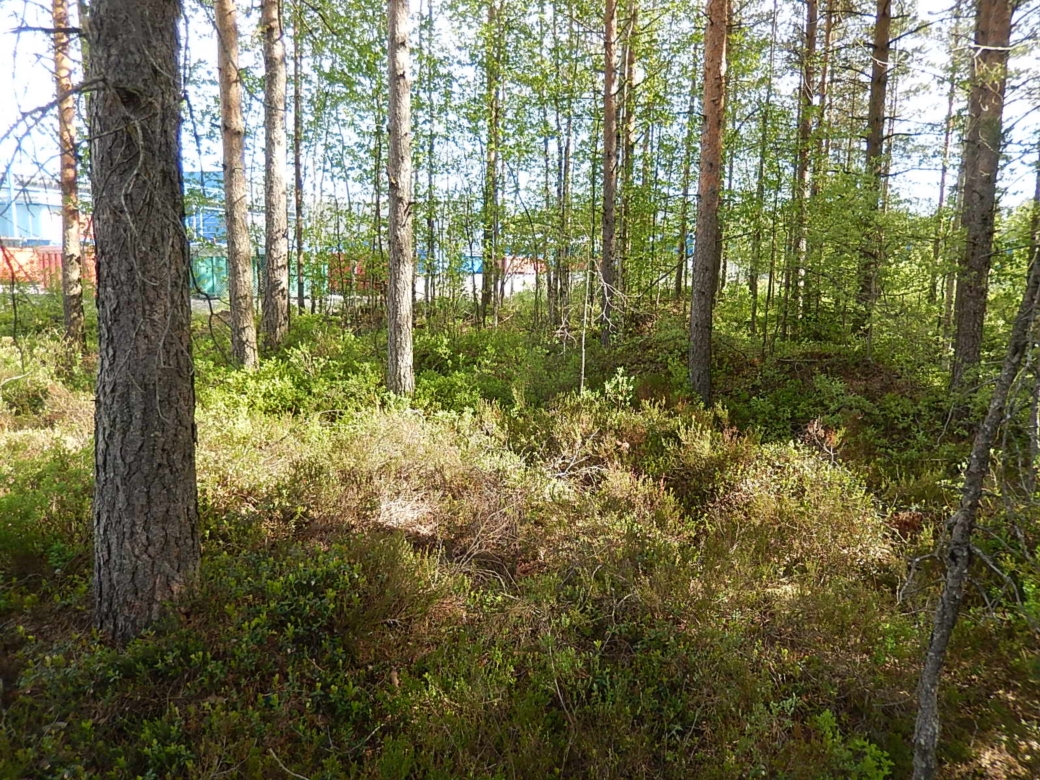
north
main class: Woodland
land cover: Pine dominated coniferous woodland
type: boreal forest
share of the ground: > 75 %
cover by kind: coniferous forest trees 75 %, shrubs 15 %, broadleaved forest trees 10 %
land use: Forestry
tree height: > 5 m
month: June
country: FI
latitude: 61.9789
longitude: 22.2876
